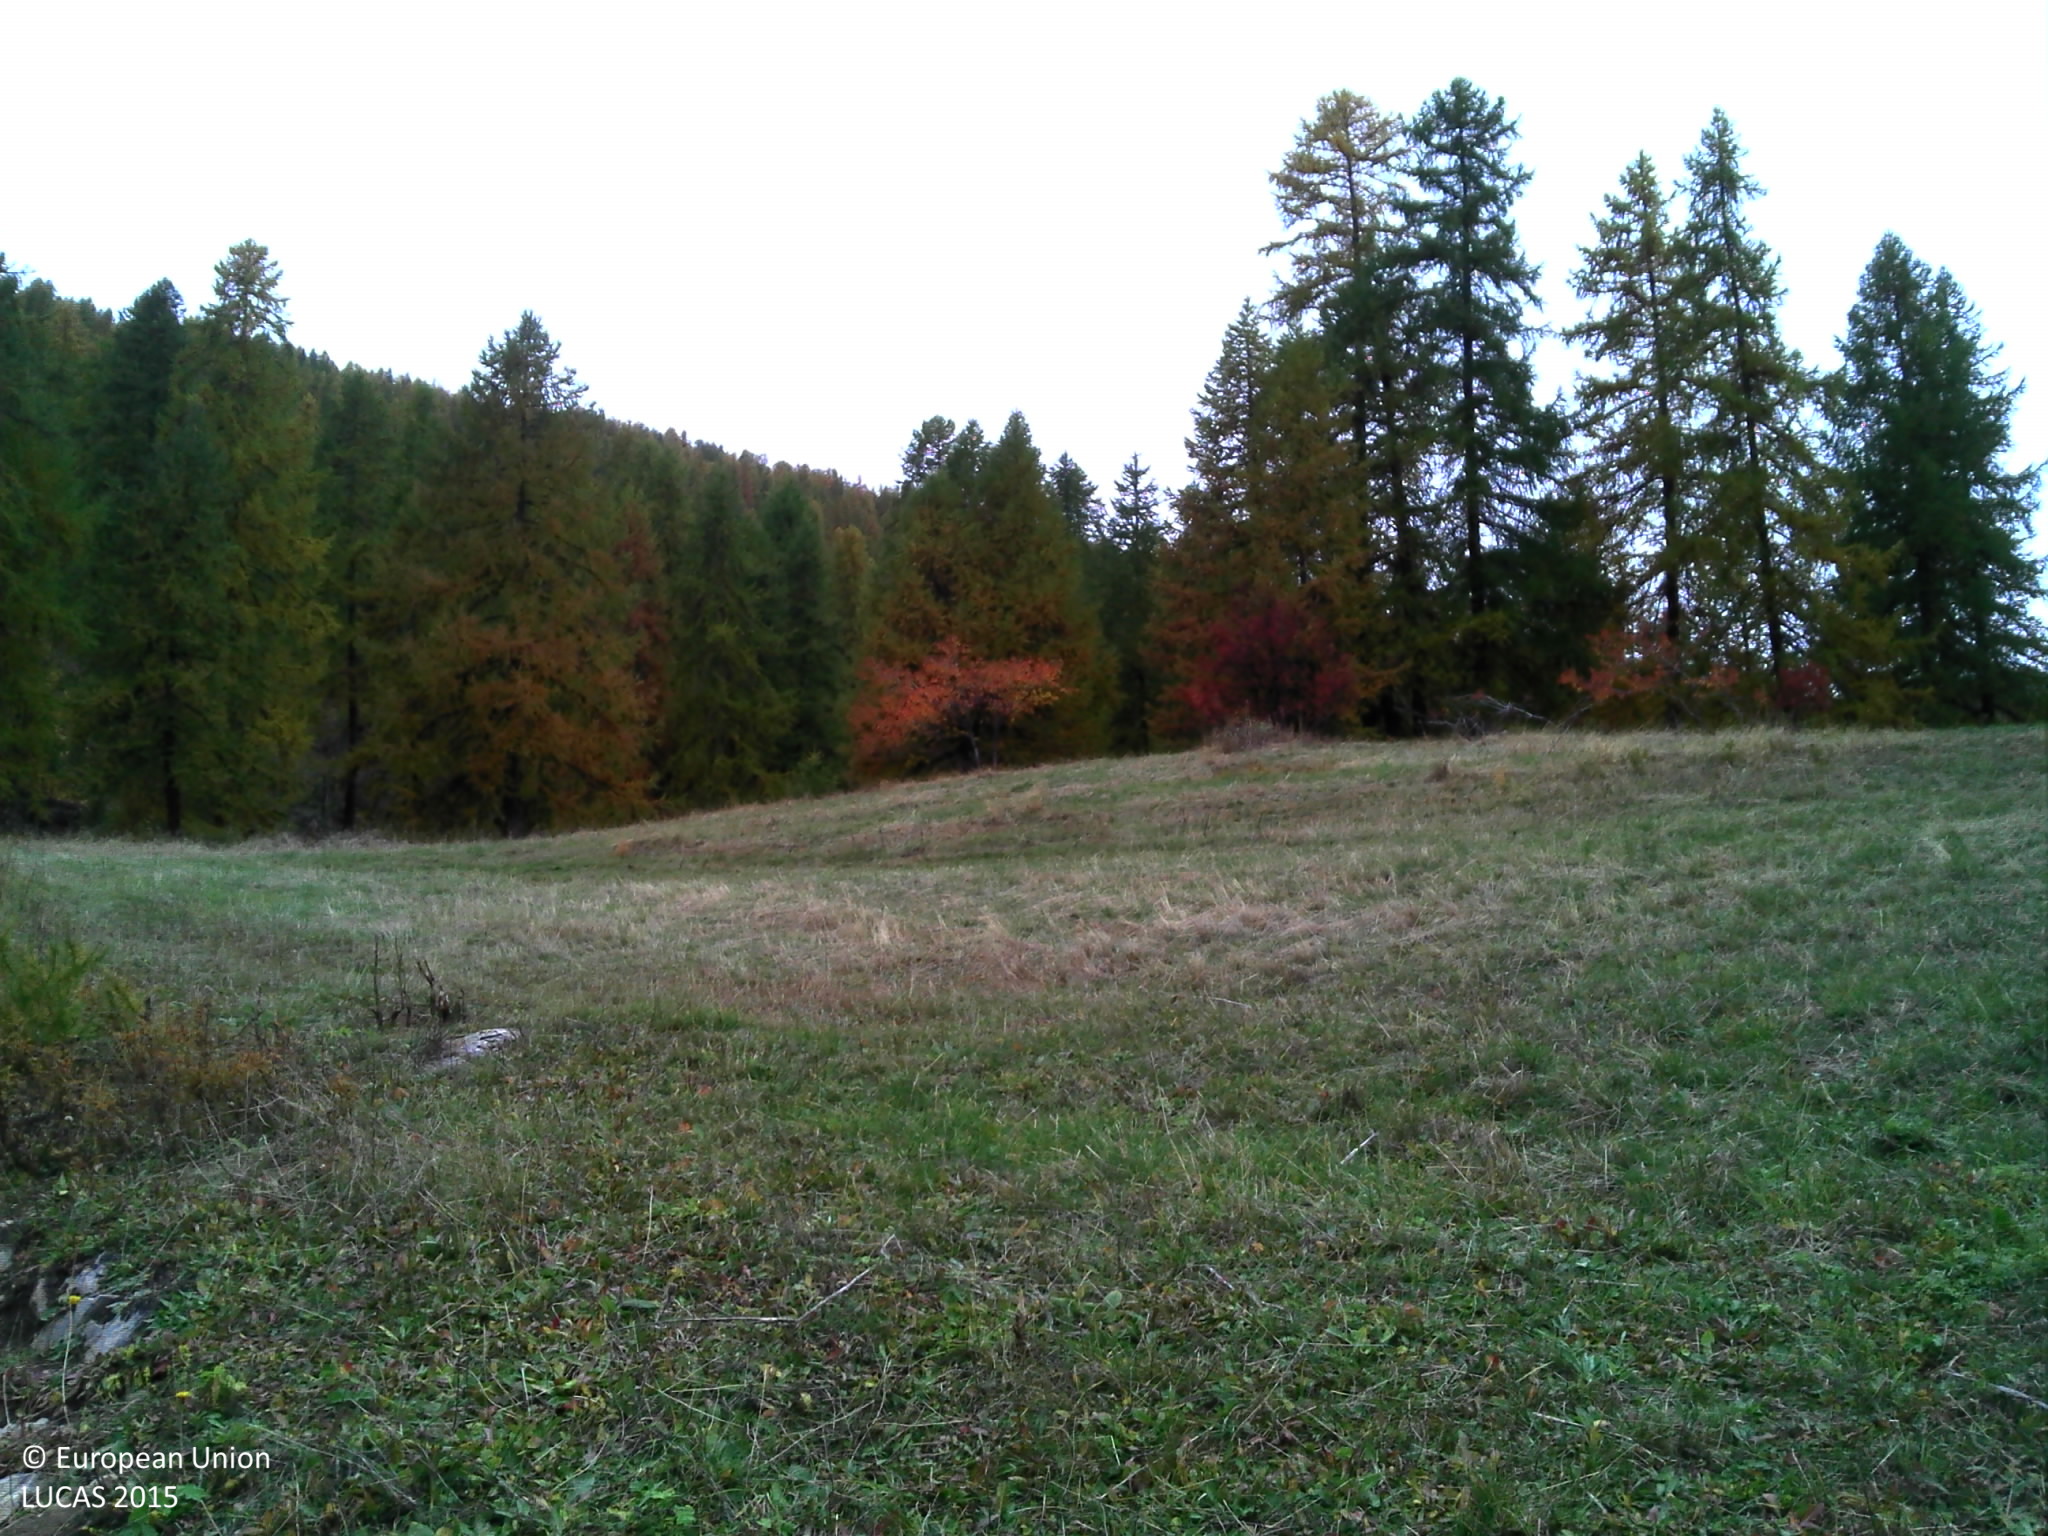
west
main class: Grassland
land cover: Grassland without tree/shrub cover
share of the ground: > 75 %
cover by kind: herbaceous plants 95 %, unconsolidated bare surface 5 %
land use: Agriculture (excluding fallow land and kitchen gardens)
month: October
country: FR
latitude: 44.8142
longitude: 6.4778
